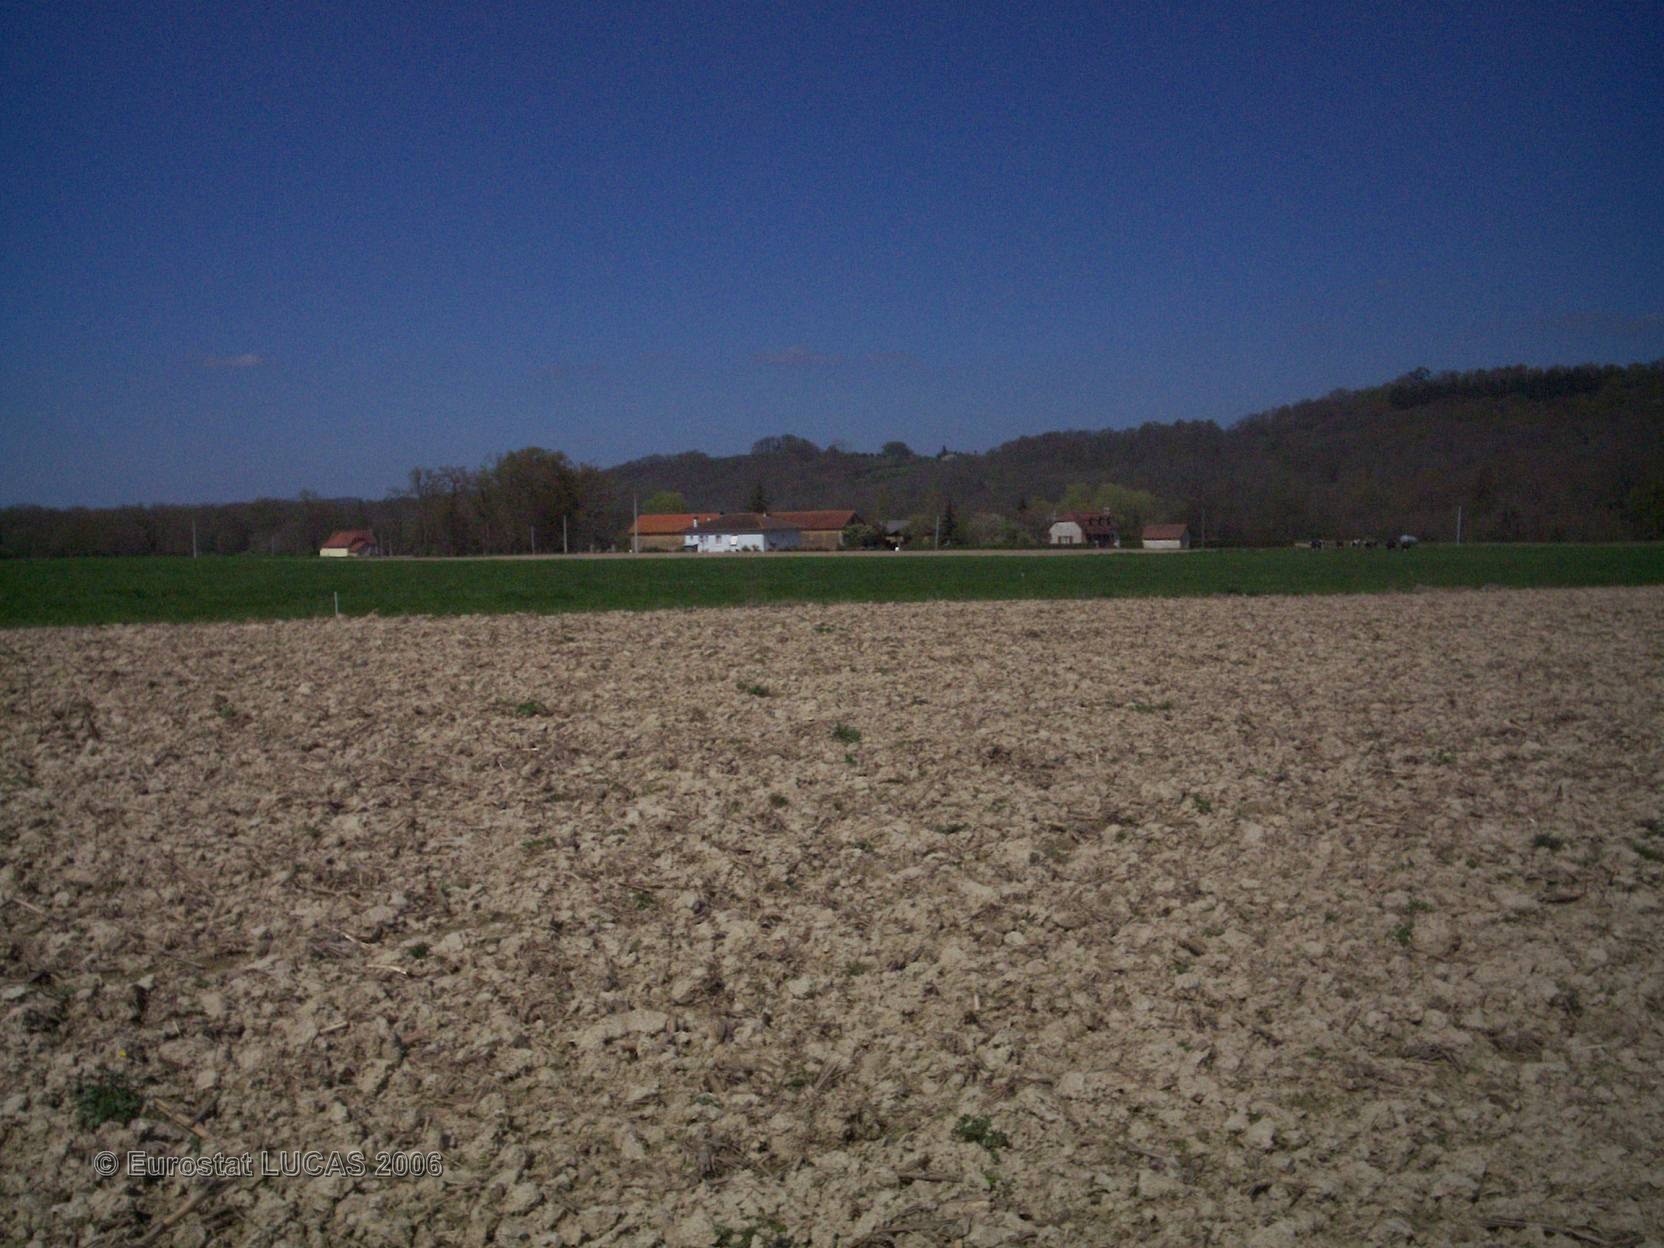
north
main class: Cropland
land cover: Maize
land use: Agriculture (excluding fallow land and kitchen gardens)
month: June
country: FR
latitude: 43.5238
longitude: -0.3390
